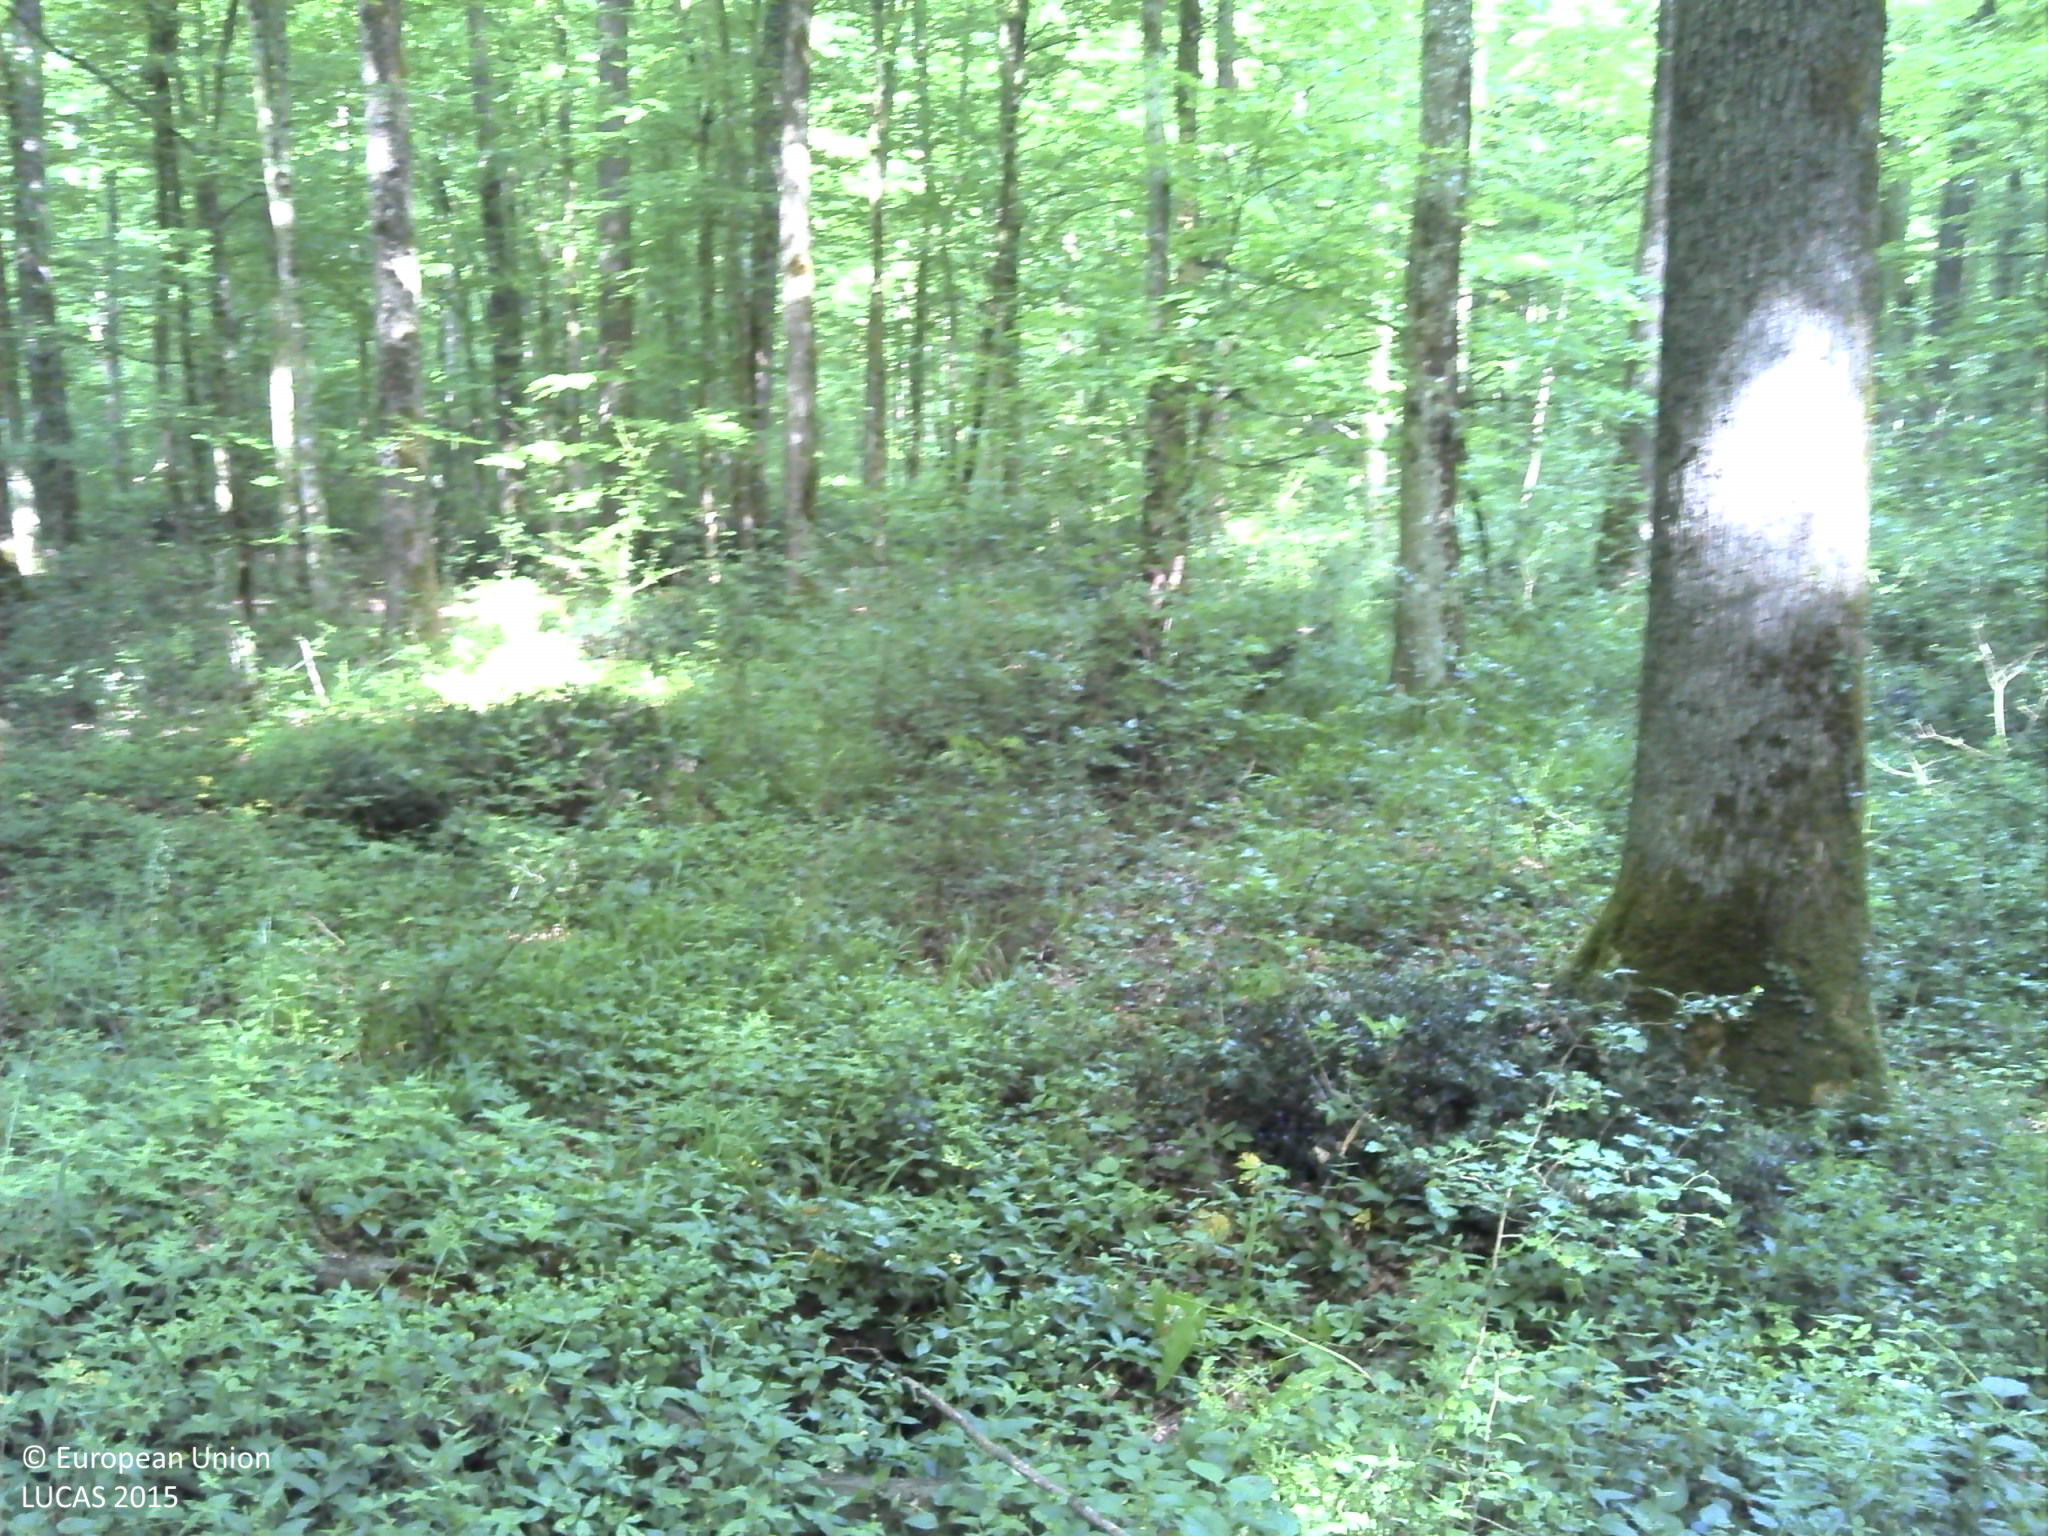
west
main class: Woodland
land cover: Broadleaved woodland
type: acidophilous oak and oak-birch forest
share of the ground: > 75 %
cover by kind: broadleaved forest trees 100 %
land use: Forestry
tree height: > 5 m
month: May
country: HR
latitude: 45.6156
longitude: 18.2512
